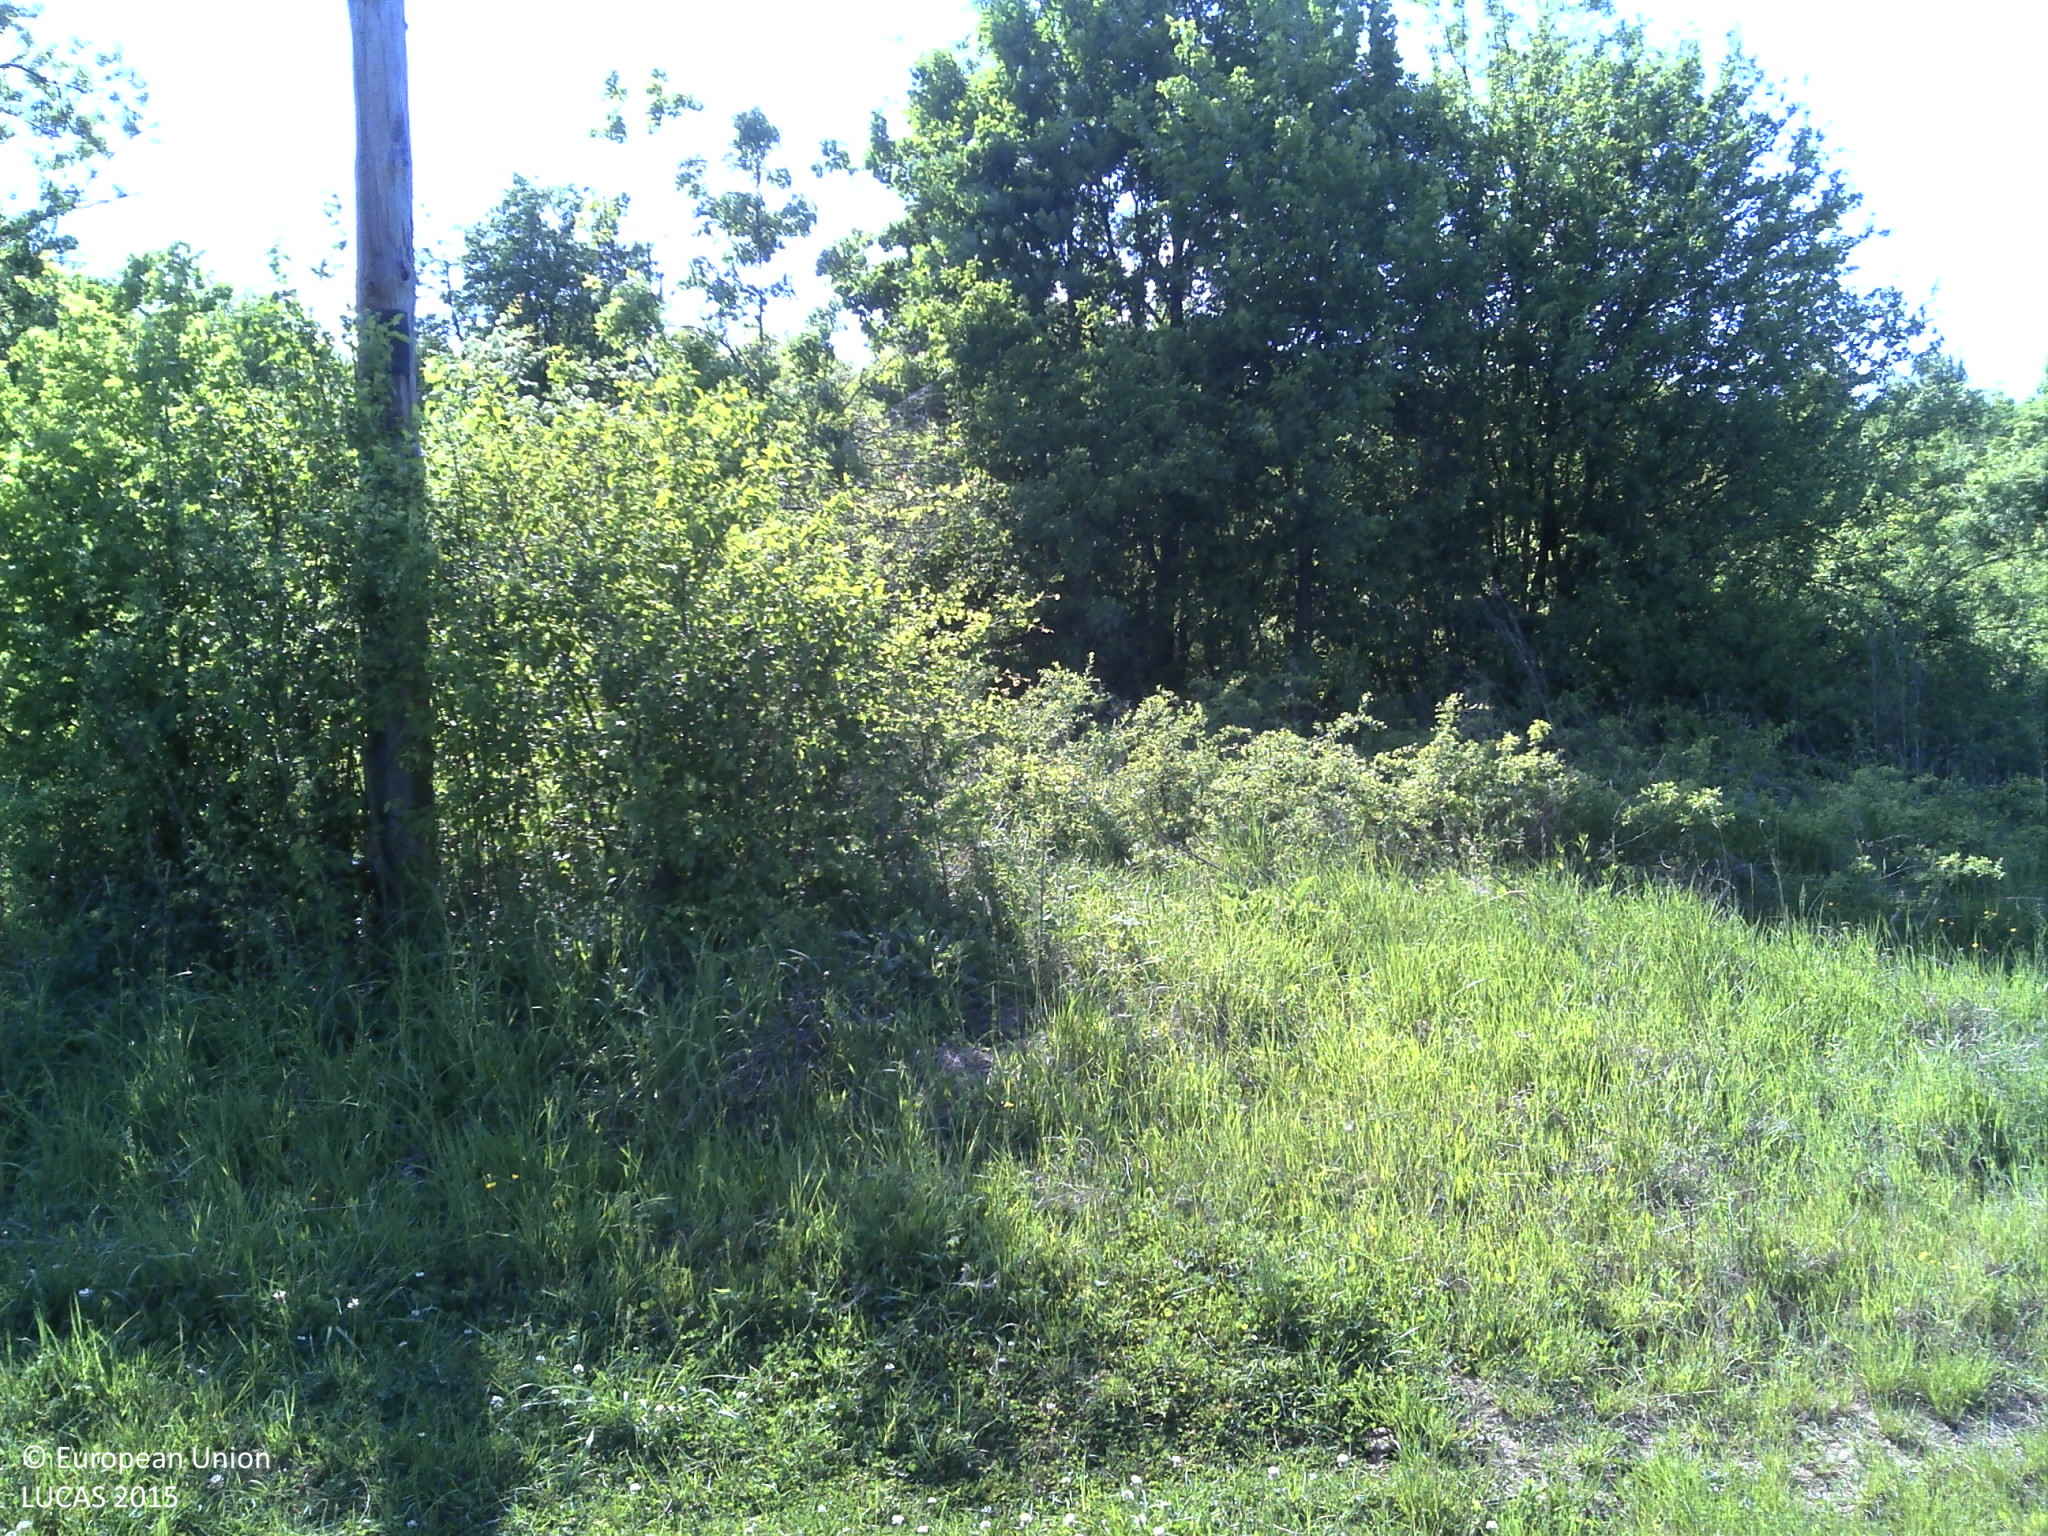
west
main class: Cropland
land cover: Clovers
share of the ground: > 75 %
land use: Agriculture (excluding fallow land and kitchen gardens)
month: May
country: HR
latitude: 45.2297
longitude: 18.0910
